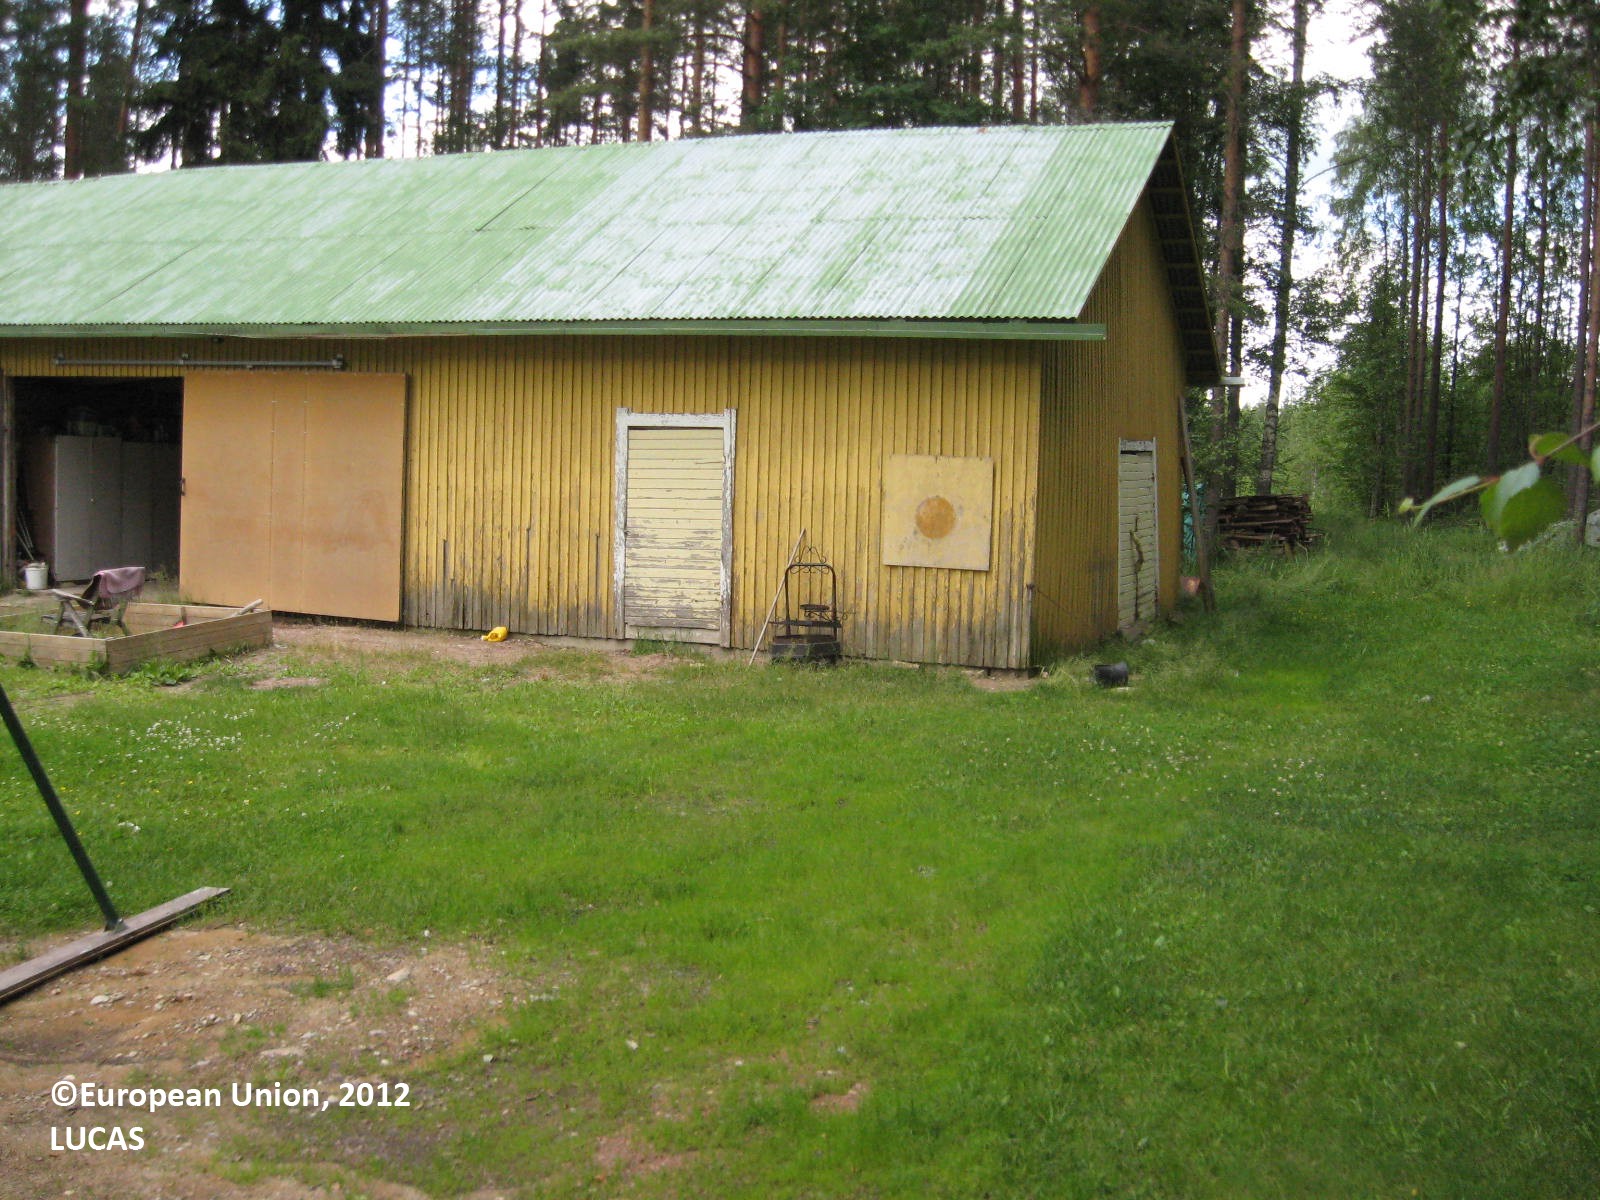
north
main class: Woodland
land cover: Pine dominated coniferous woodland
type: boreal forest
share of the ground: > 75 %
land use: Forestry
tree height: > 5 m
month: July
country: FI
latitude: 62.3104
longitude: 22.6951
